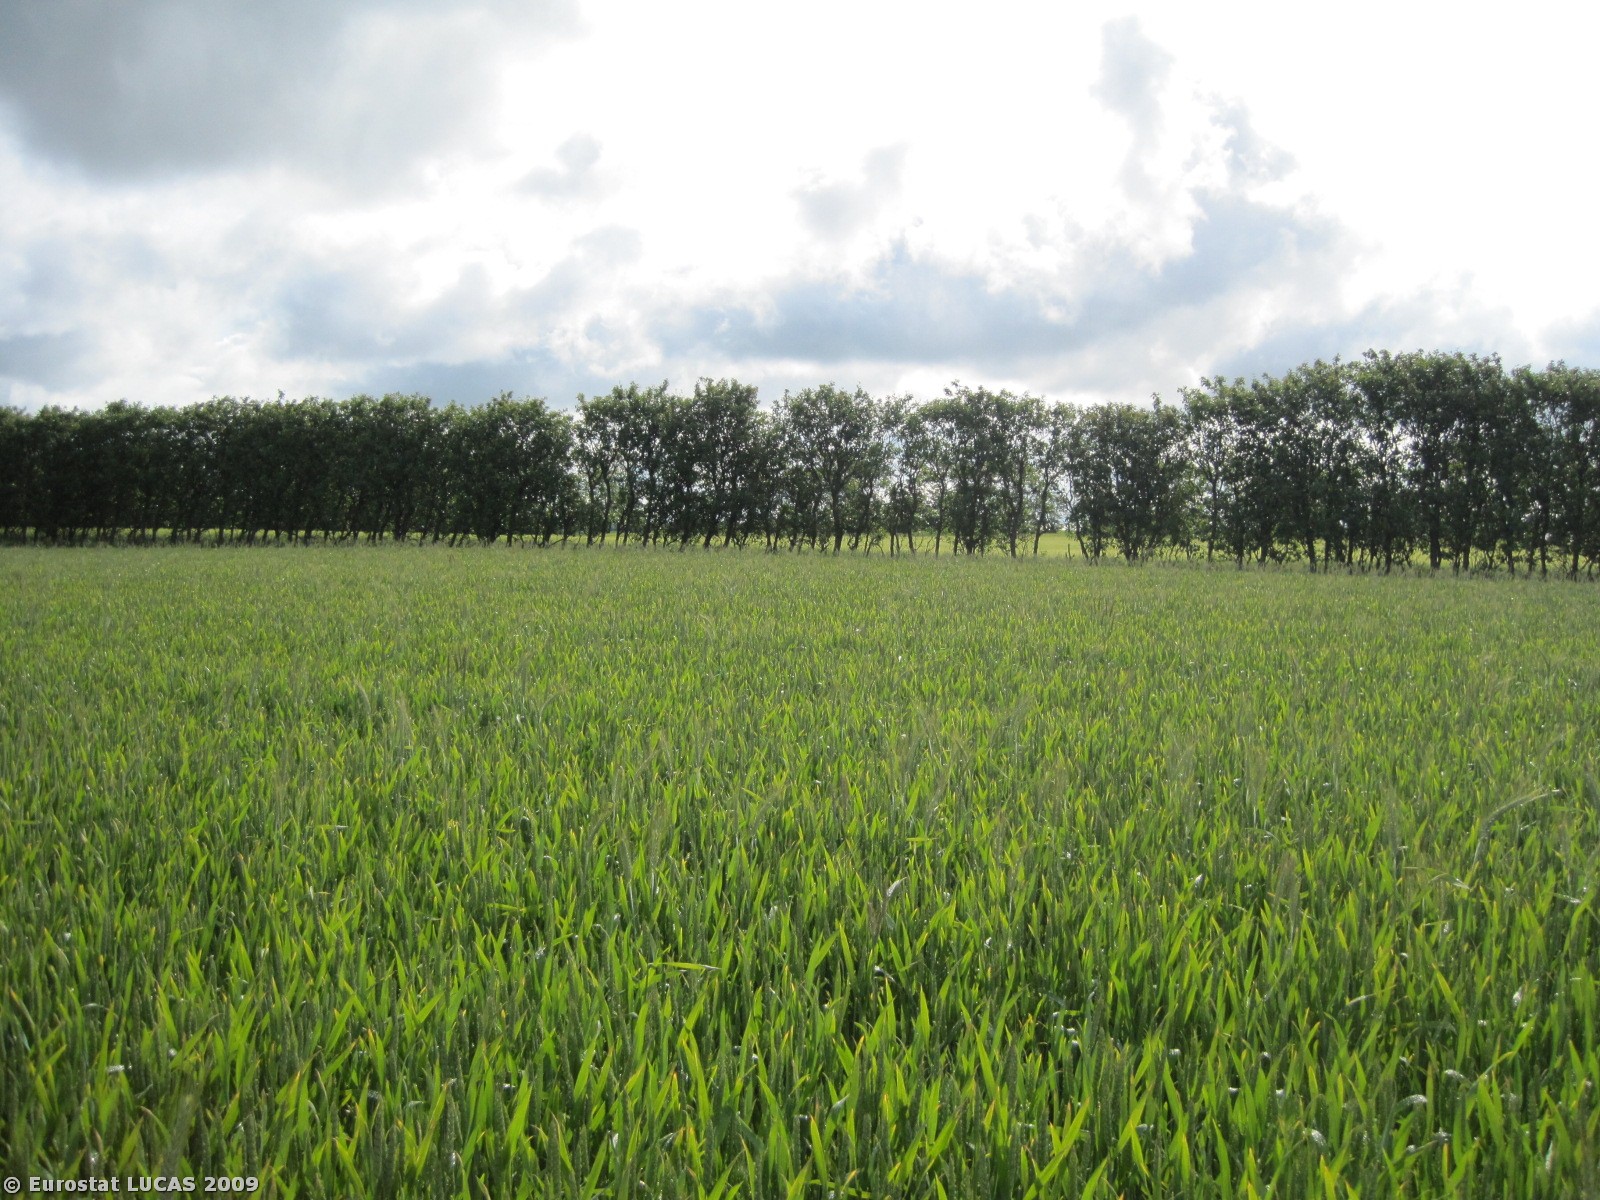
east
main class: Cropland
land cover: Common wheat
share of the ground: > 75 %
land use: Agriculture (excluding fallow land and kitchen gardens)
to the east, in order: Common wheat; Grass margins; Broadleaved woodland; Grass margins; Barley; Grass margins; Broadleaved woodland; Grass margins; Common wheat
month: June
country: DK
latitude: 57.3203
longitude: 10.0497
